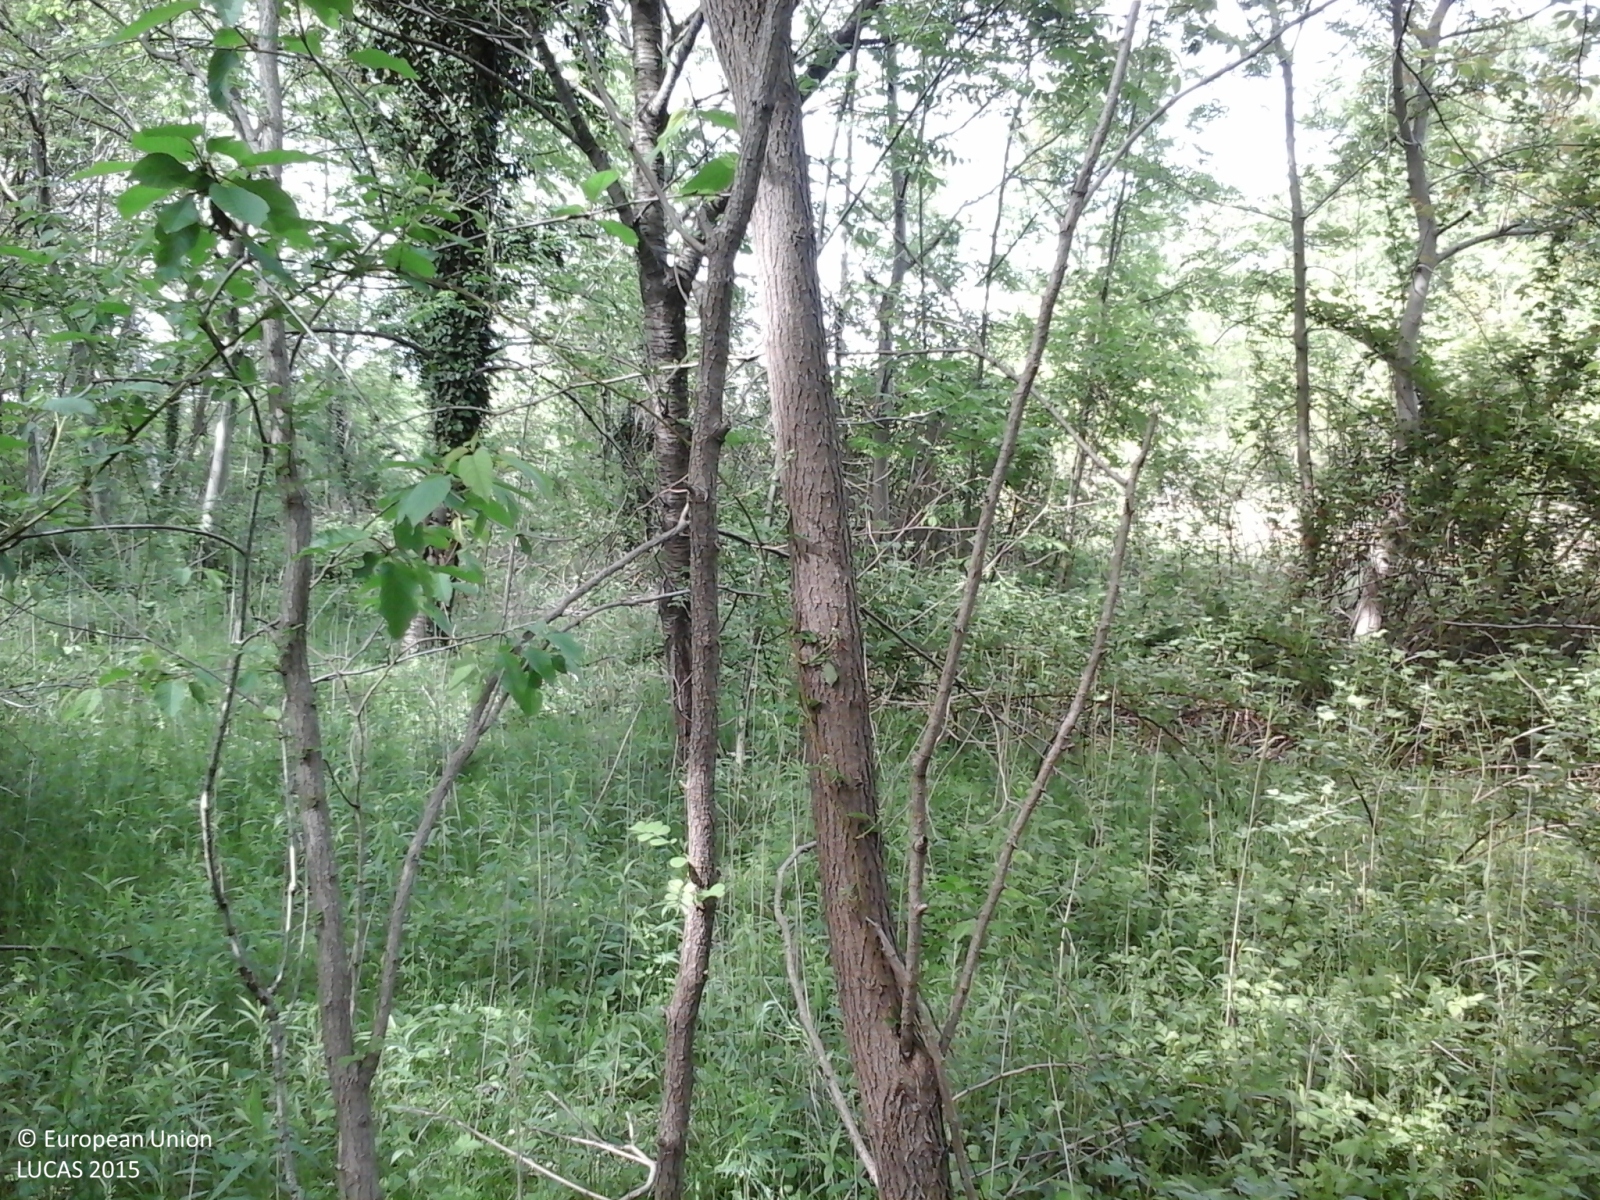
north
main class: Woodland
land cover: Broadleaved woodland
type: thermophilous deciduous forest
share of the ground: > 75 %
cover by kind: broadleaved forest trees 100 %
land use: Forestry
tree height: > 5 m
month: May
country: IT
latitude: 45.6556
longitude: 8.4753
